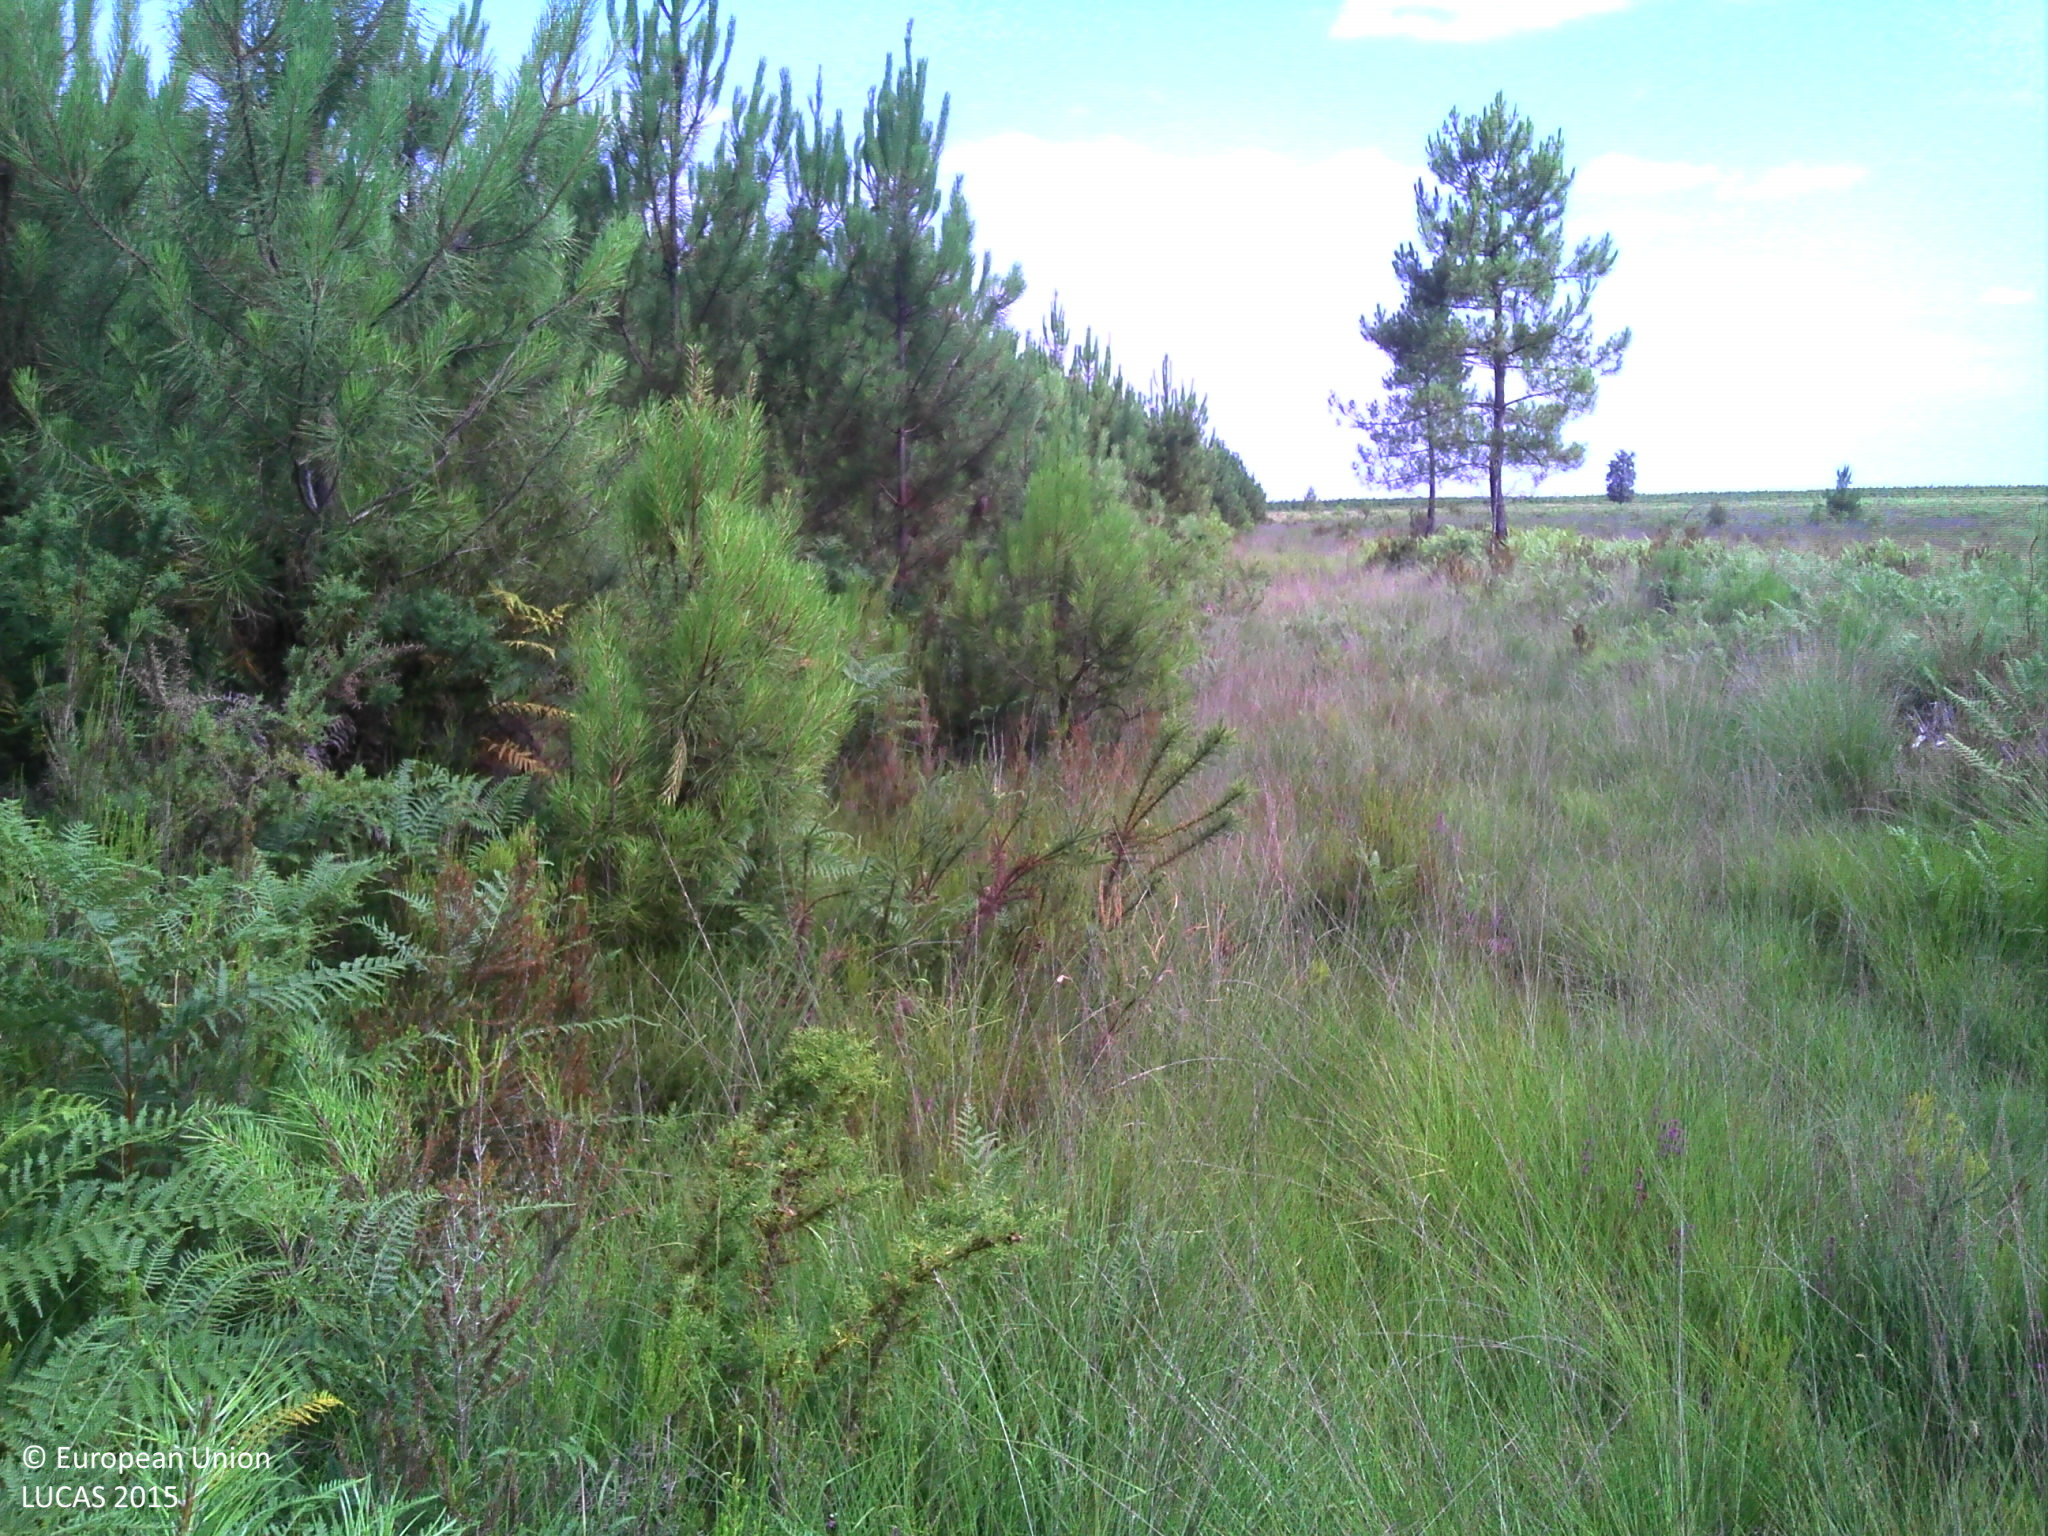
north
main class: Woodland
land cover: Pine dominated coniferous woodland
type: coniferous forest of the mediterranean region
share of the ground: 50 - 75 %
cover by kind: coniferous forest trees 60 %, herbaceous plants 40 %
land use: Forestry
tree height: < 5 m
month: July
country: FR
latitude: 44.1842
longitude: -0.6357
